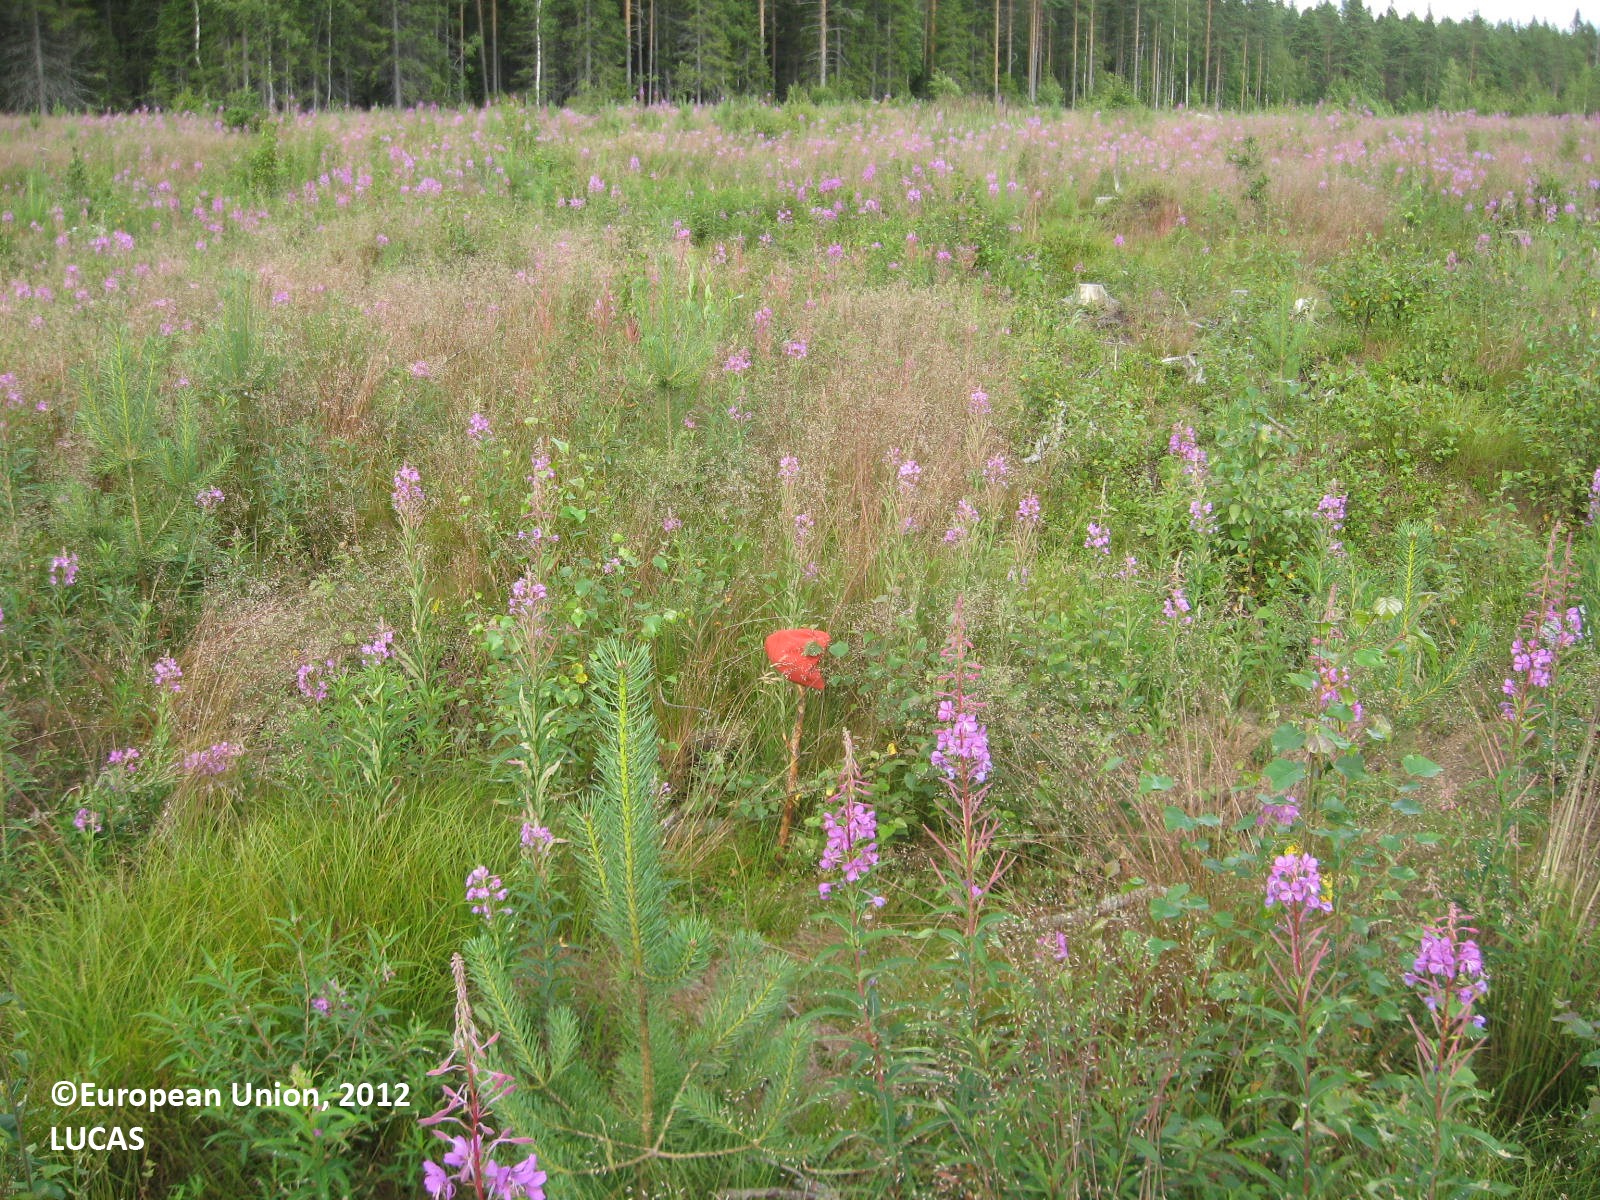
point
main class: Grassland
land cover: Grassland with sparse tree/shrub cover
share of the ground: 10 - 25 %
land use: Forestry
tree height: < 5 m
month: July
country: FI
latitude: 62.2121
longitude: 22.3422
